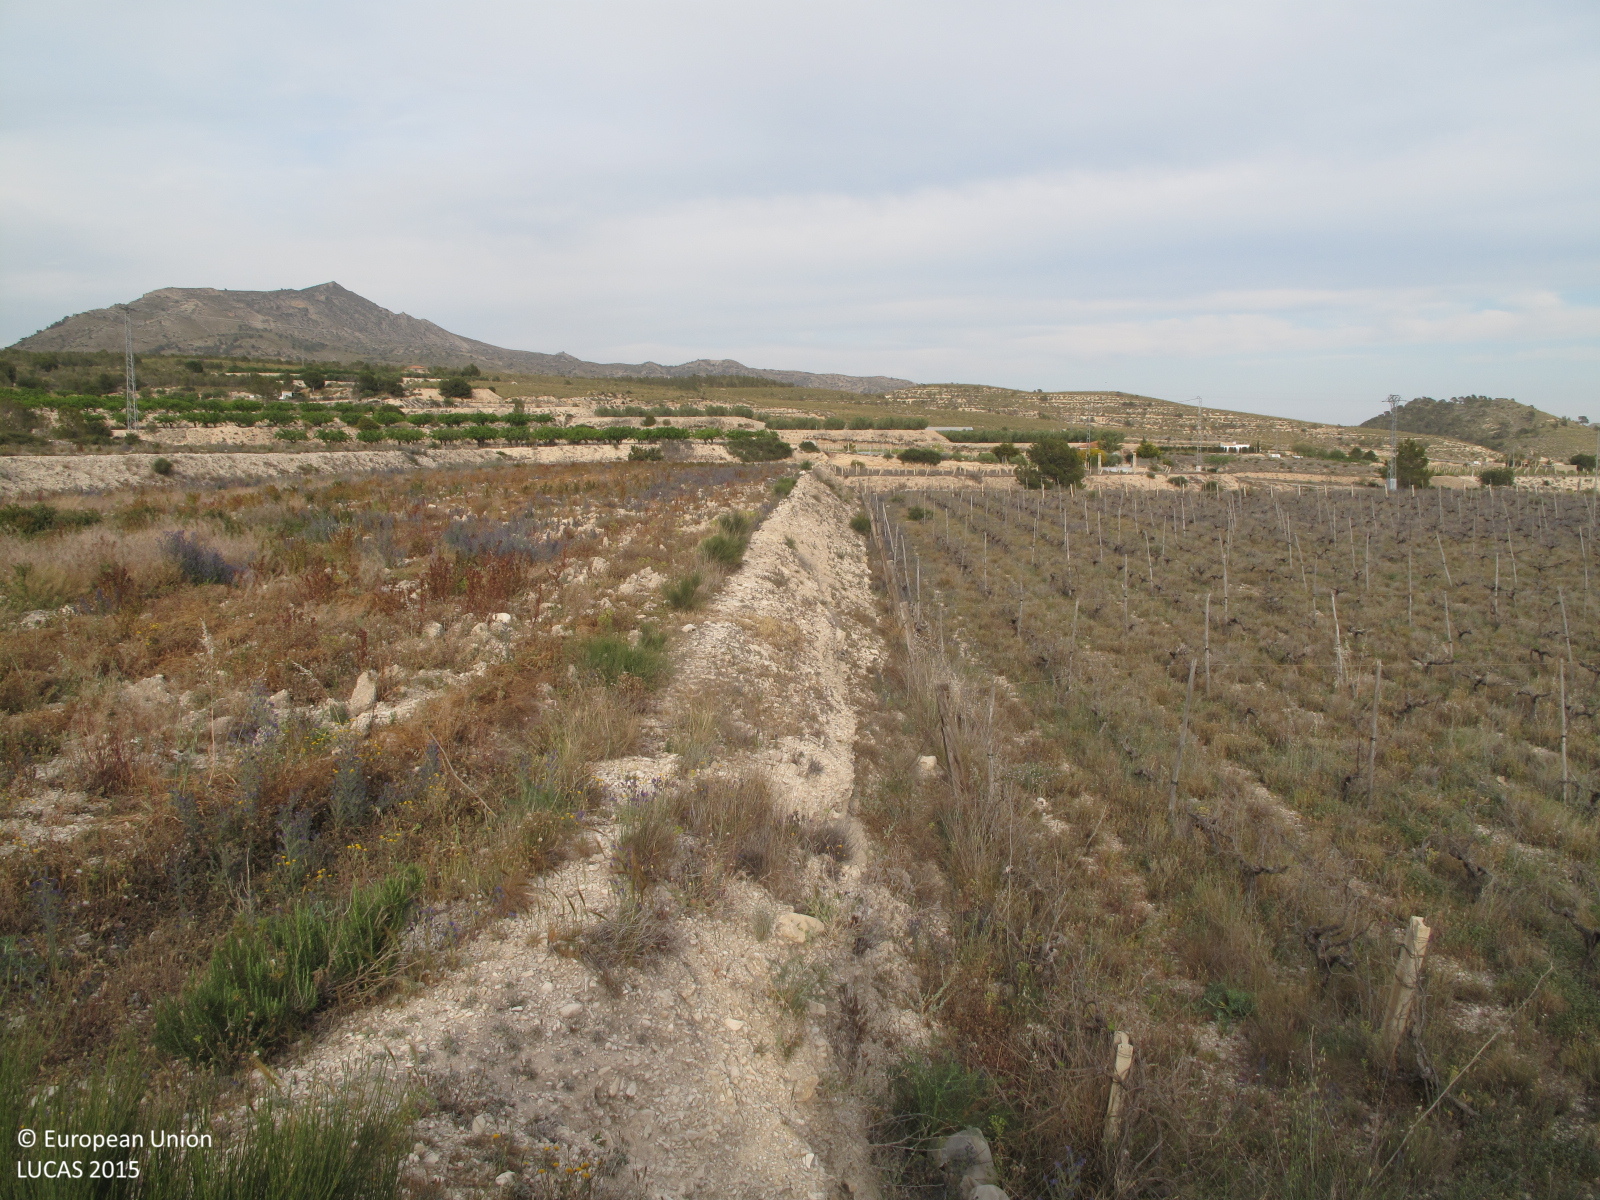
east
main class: Grassland
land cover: Spontaneously vegetated surfaces
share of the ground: > 75 %
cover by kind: herbaceous plants 80 %, unconsolidated bare surface 20 %
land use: Abandoned areas
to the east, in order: Grass margins; Spontaneously vegetated surfaces; Grassland with sparse tree/shrub cover; Vineyards; Grass margins; Paved roads, cycling and walking lanes; Fences; Vineyards
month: April
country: ES
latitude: 38.4625
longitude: -0.6571
